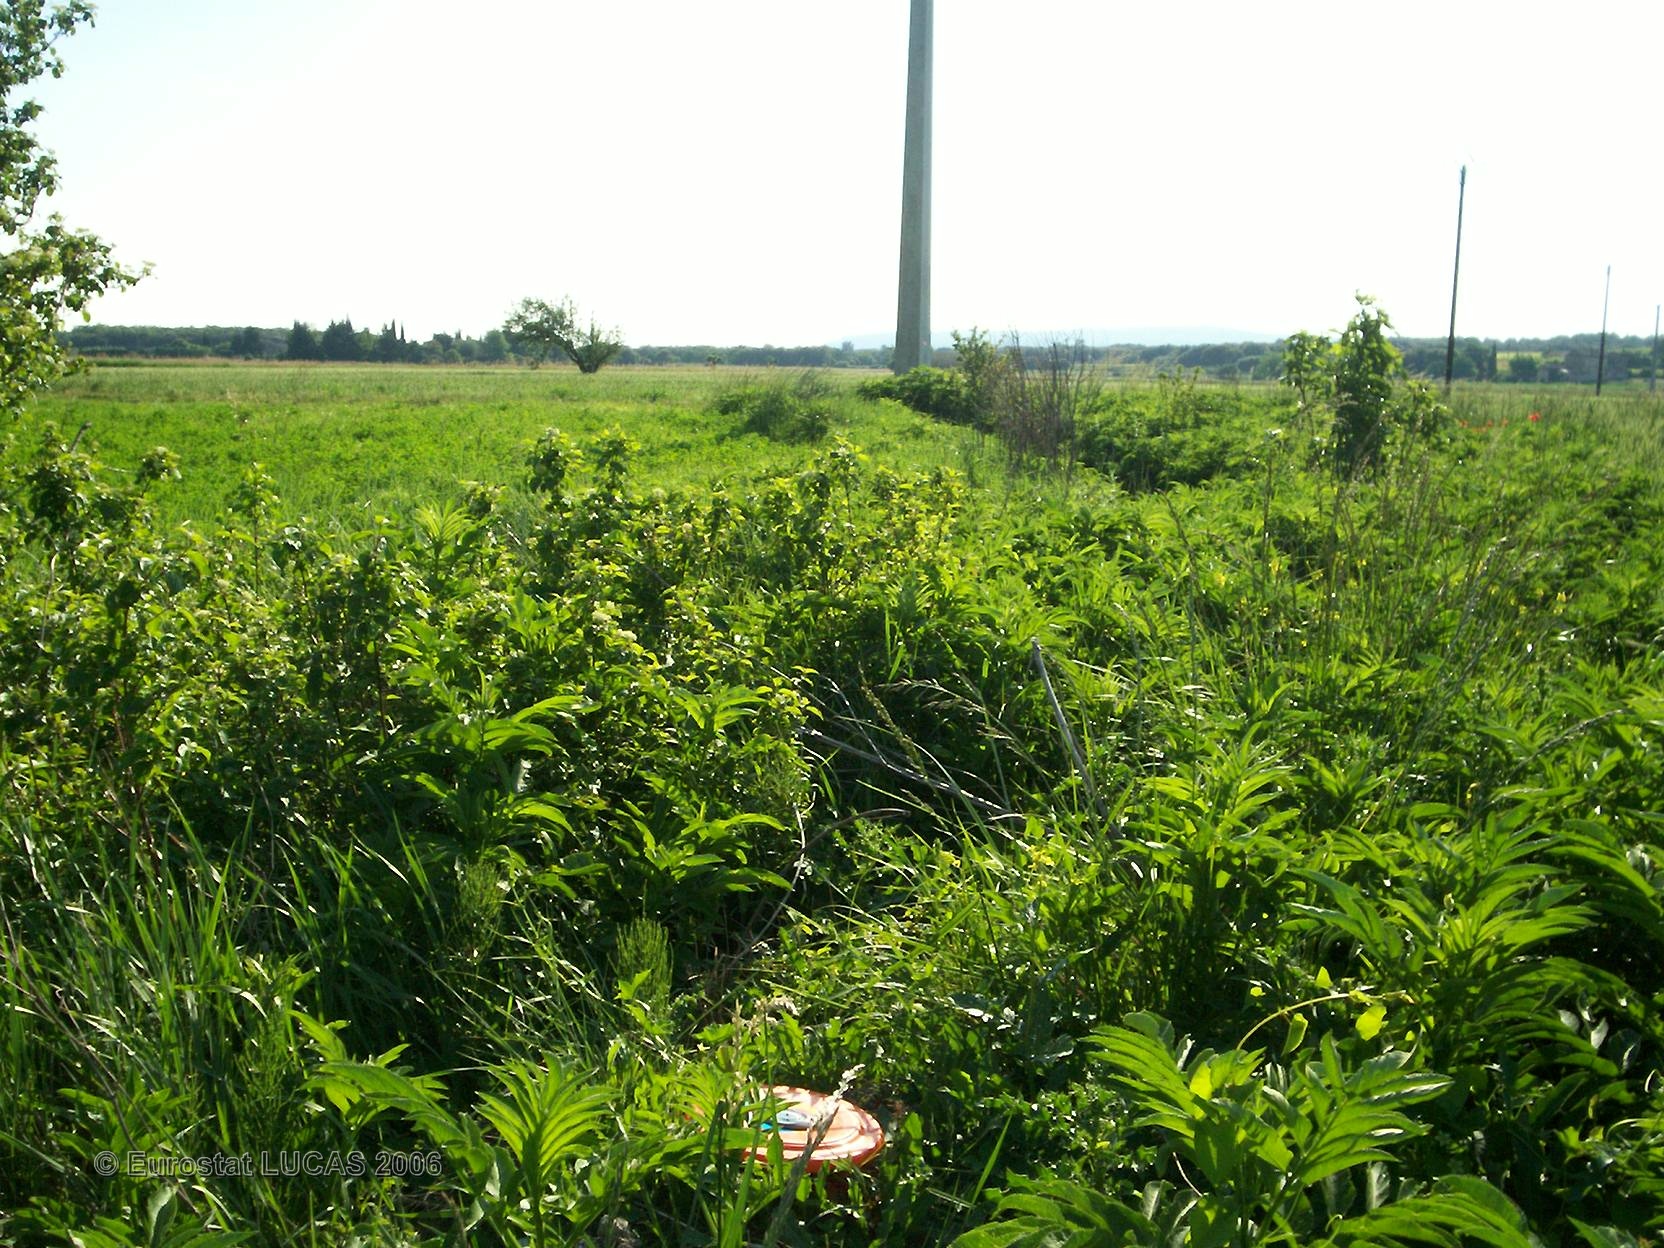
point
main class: Cropland
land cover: Barley
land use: Agriculture (excluding fallow land and kitchen gardens)
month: May
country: FR
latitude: 44.3313
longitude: 4.8531
